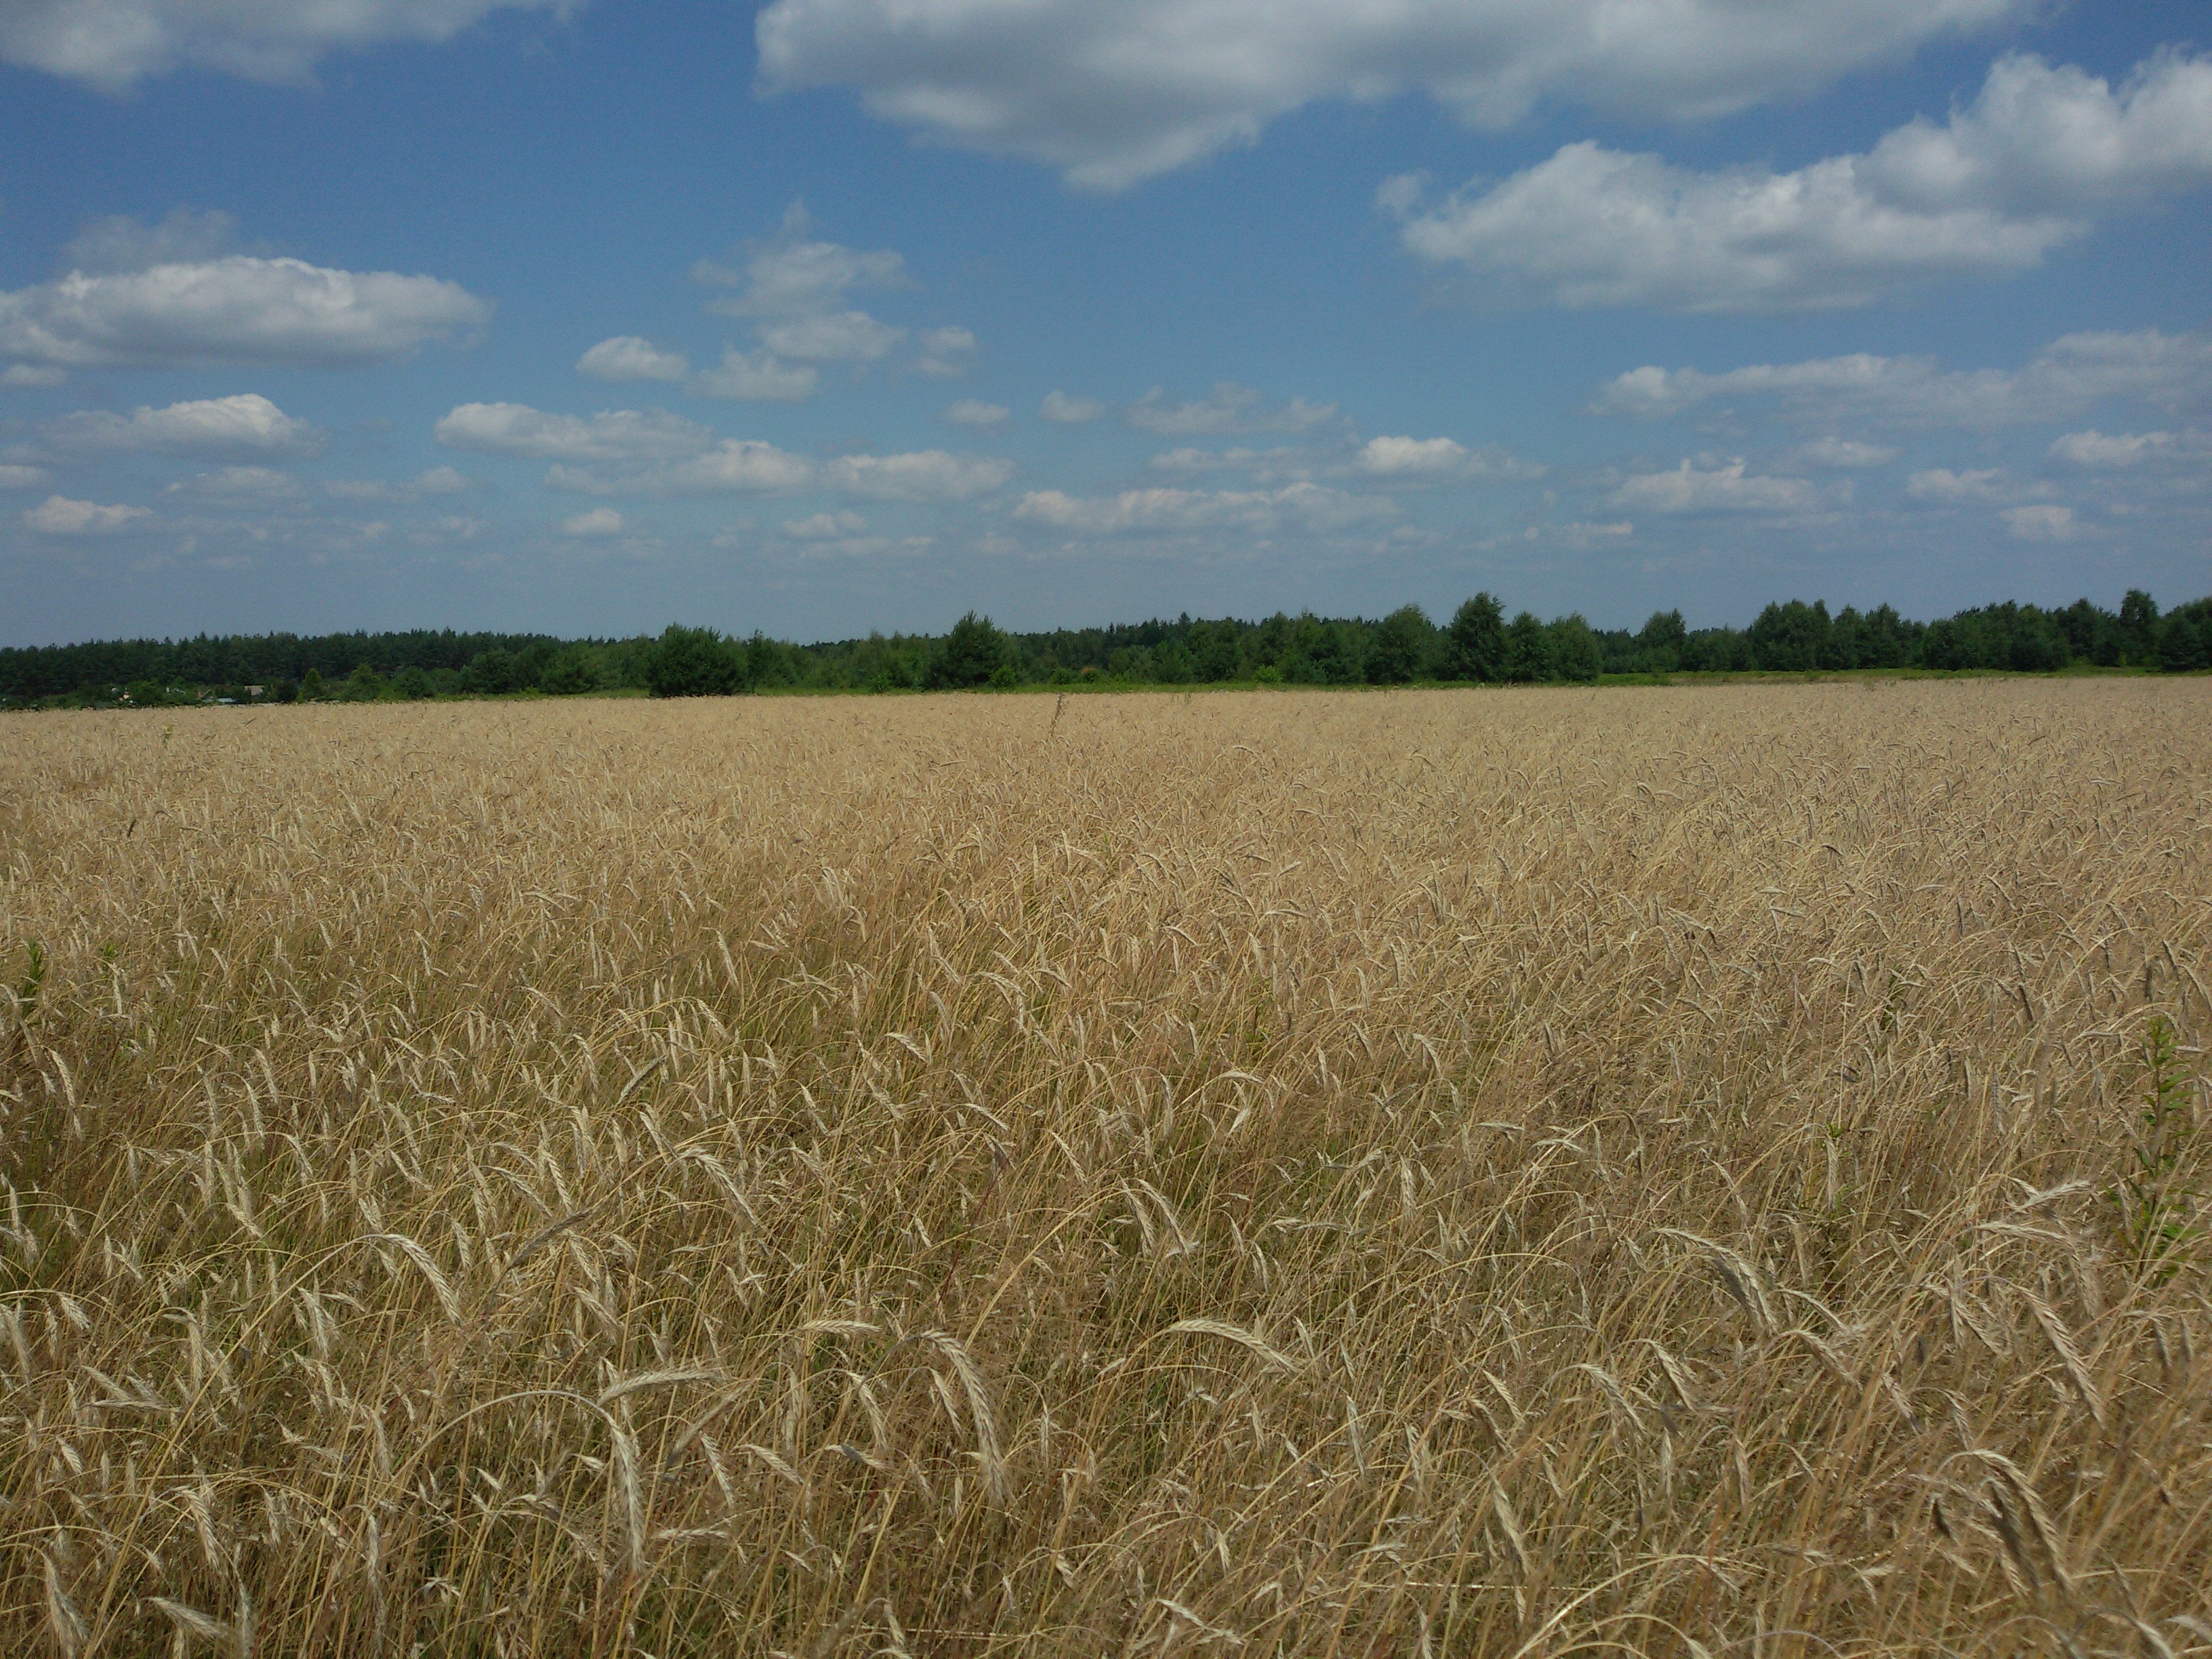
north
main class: Cropland
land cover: Rye
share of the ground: > 75 %
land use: Agriculture (excluding fallow land and kitchen gardens)
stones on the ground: < 10 %
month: July
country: PL
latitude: 50.2512
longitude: 22.3914
